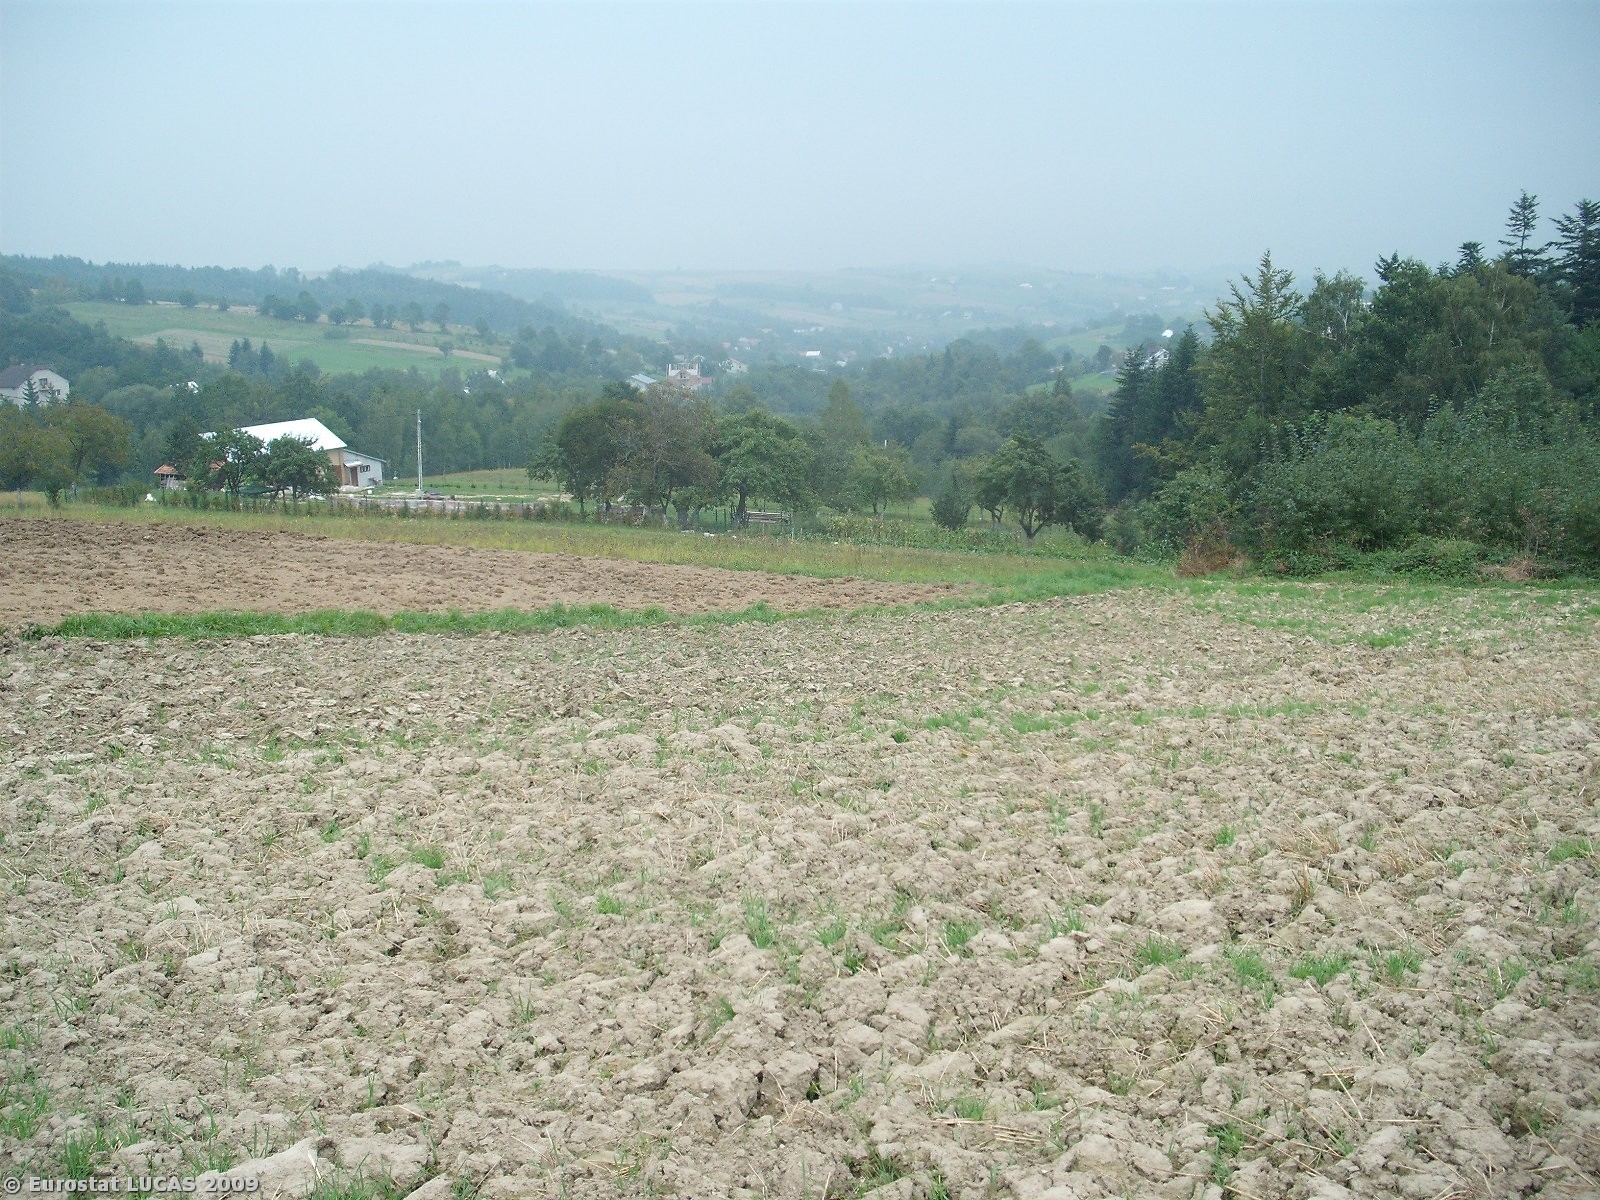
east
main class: Cropland
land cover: Common wheat
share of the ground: < 10 %
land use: Agriculture (excluding fallow land and kitchen gardens)
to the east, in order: Common wheat; Broadleaved woodland; Grassland without tree/shrub cover; Other fresh vegetables; Other root crops; Maize; Grassland with sparse tree/shrub cover; Fences; Grassland with sparse tree/shrub cover; Fences; Mixed woodland; Broadleaved woodland
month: September
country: PL
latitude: 49.6627
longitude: 21.0579
